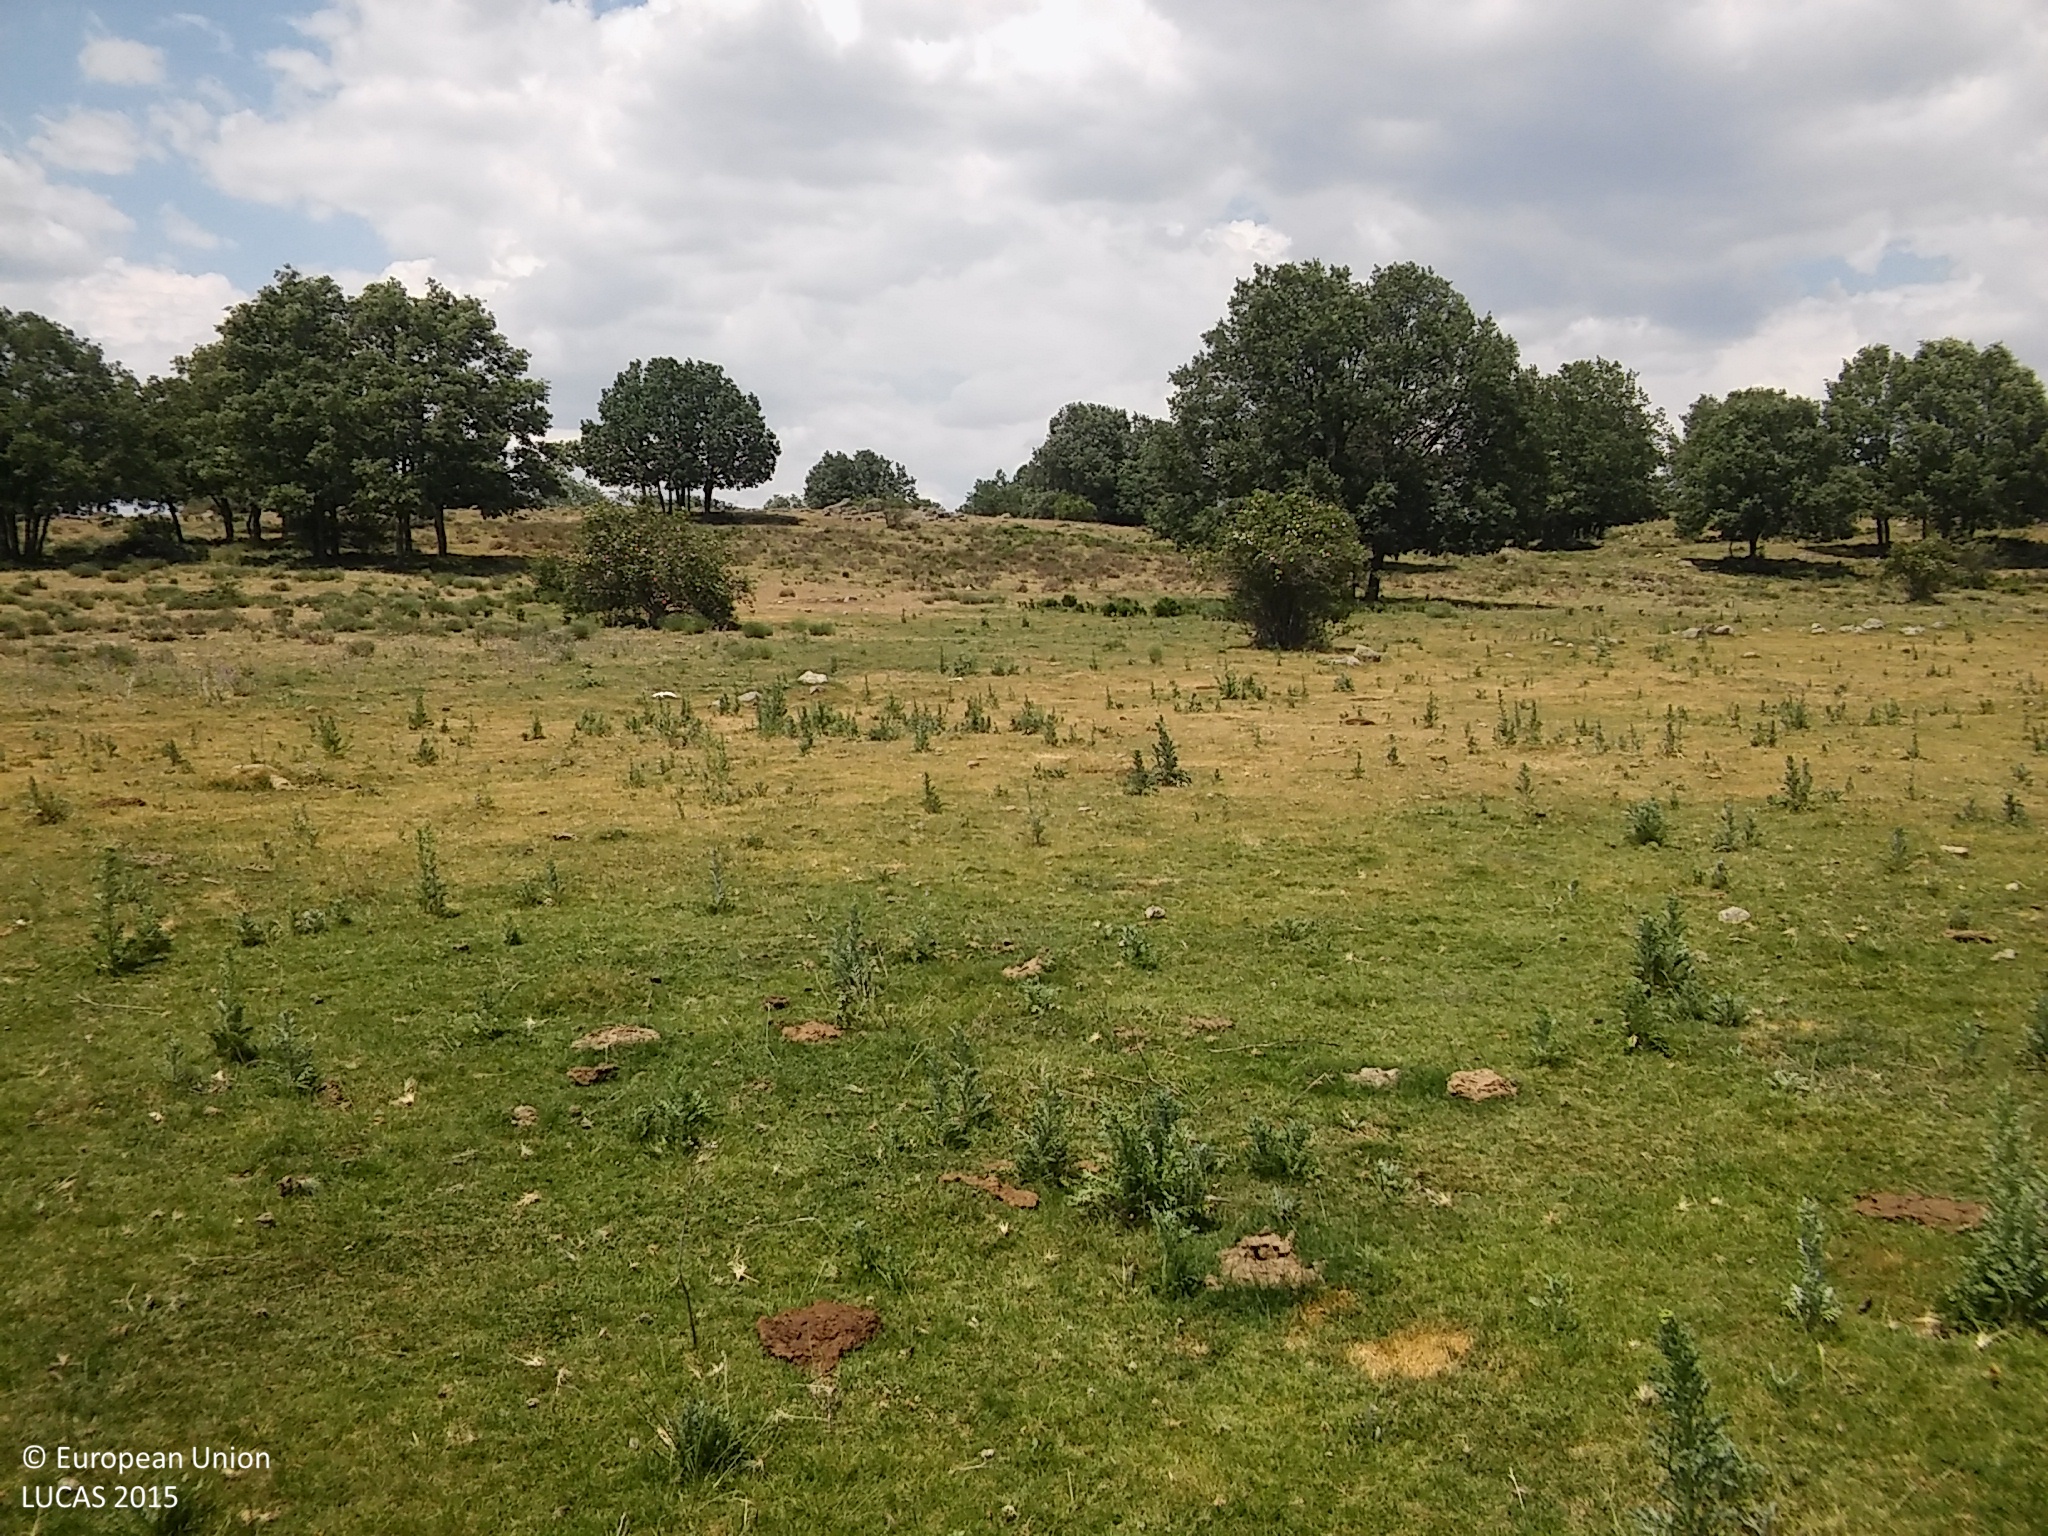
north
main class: Grassland
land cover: Grassland without tree/shrub cover
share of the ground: > 75 %
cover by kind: herbaceous plants 100 %
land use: Agriculture (excluding fallow land and kitchen gardens)
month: June
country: ES
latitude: 40.6095
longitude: -4.4104
